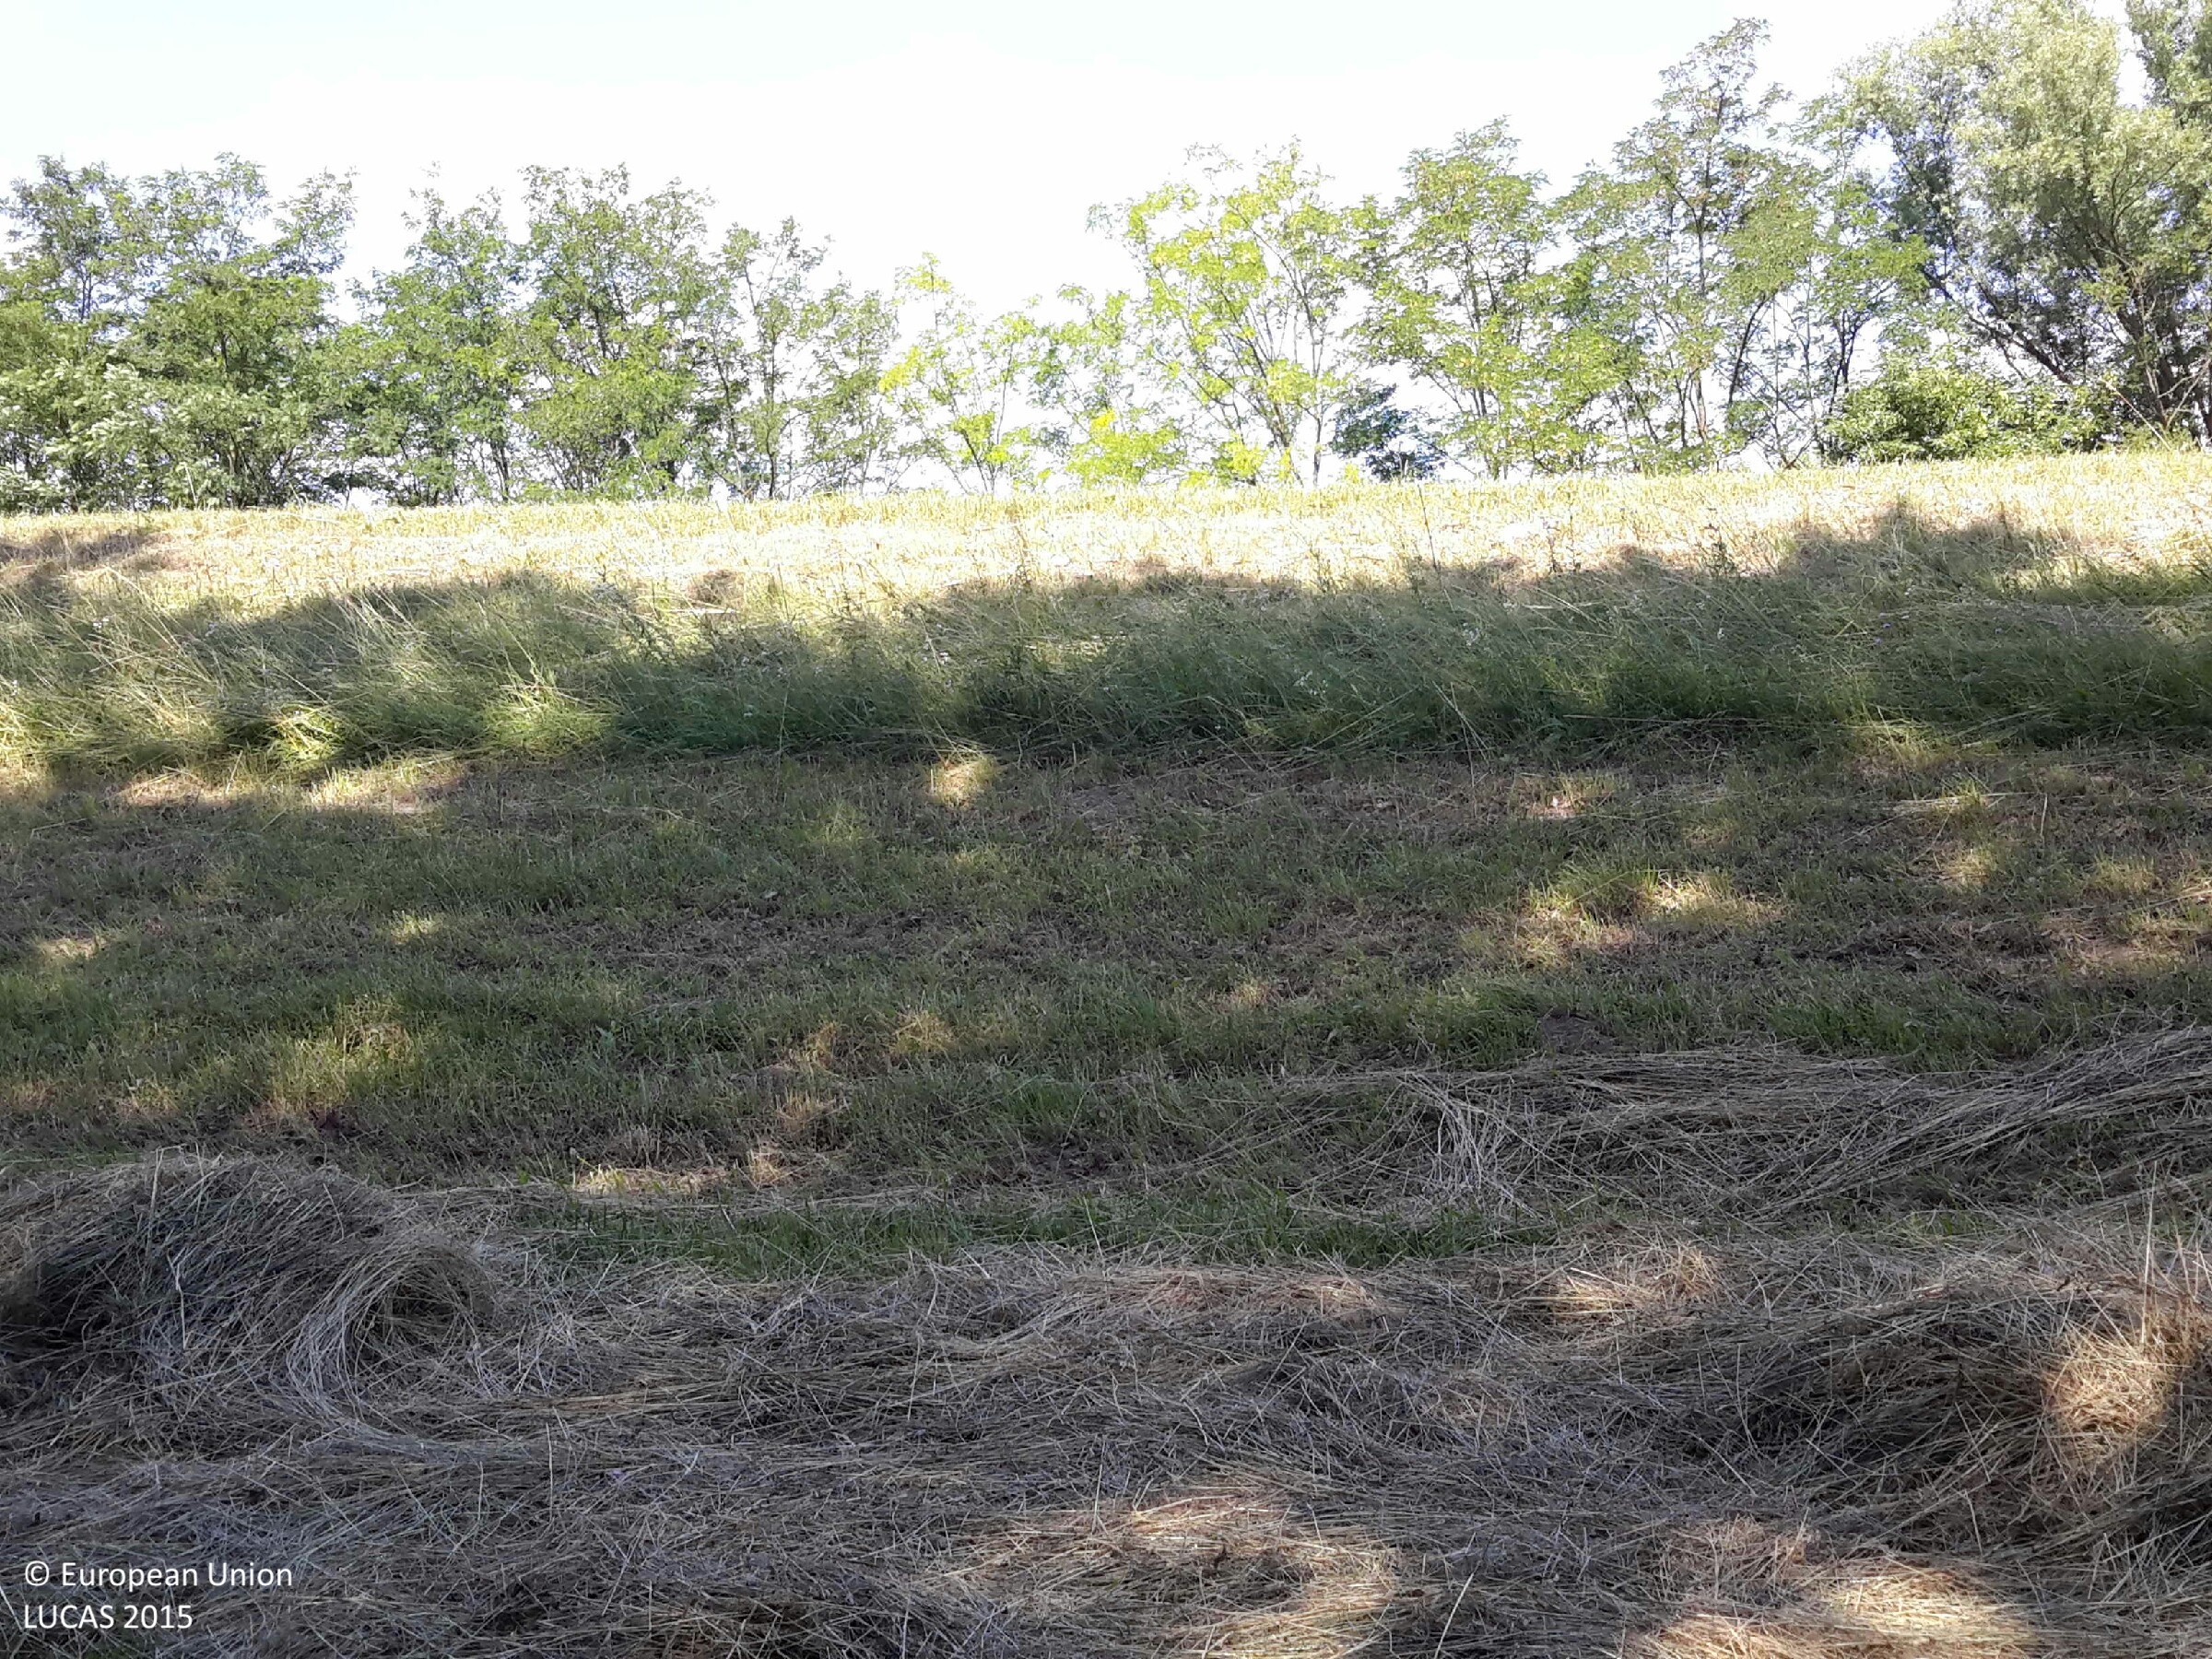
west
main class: Woodland
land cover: Broadleaved woodland
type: mire and swamp forests
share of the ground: > 75 %
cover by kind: broadleaved forest trees 80 %, herbaceous plants 15 %, shrubs 5 %
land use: Forestry
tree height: > 5 m
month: June
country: HU
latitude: 47.6924
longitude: 17.5635
